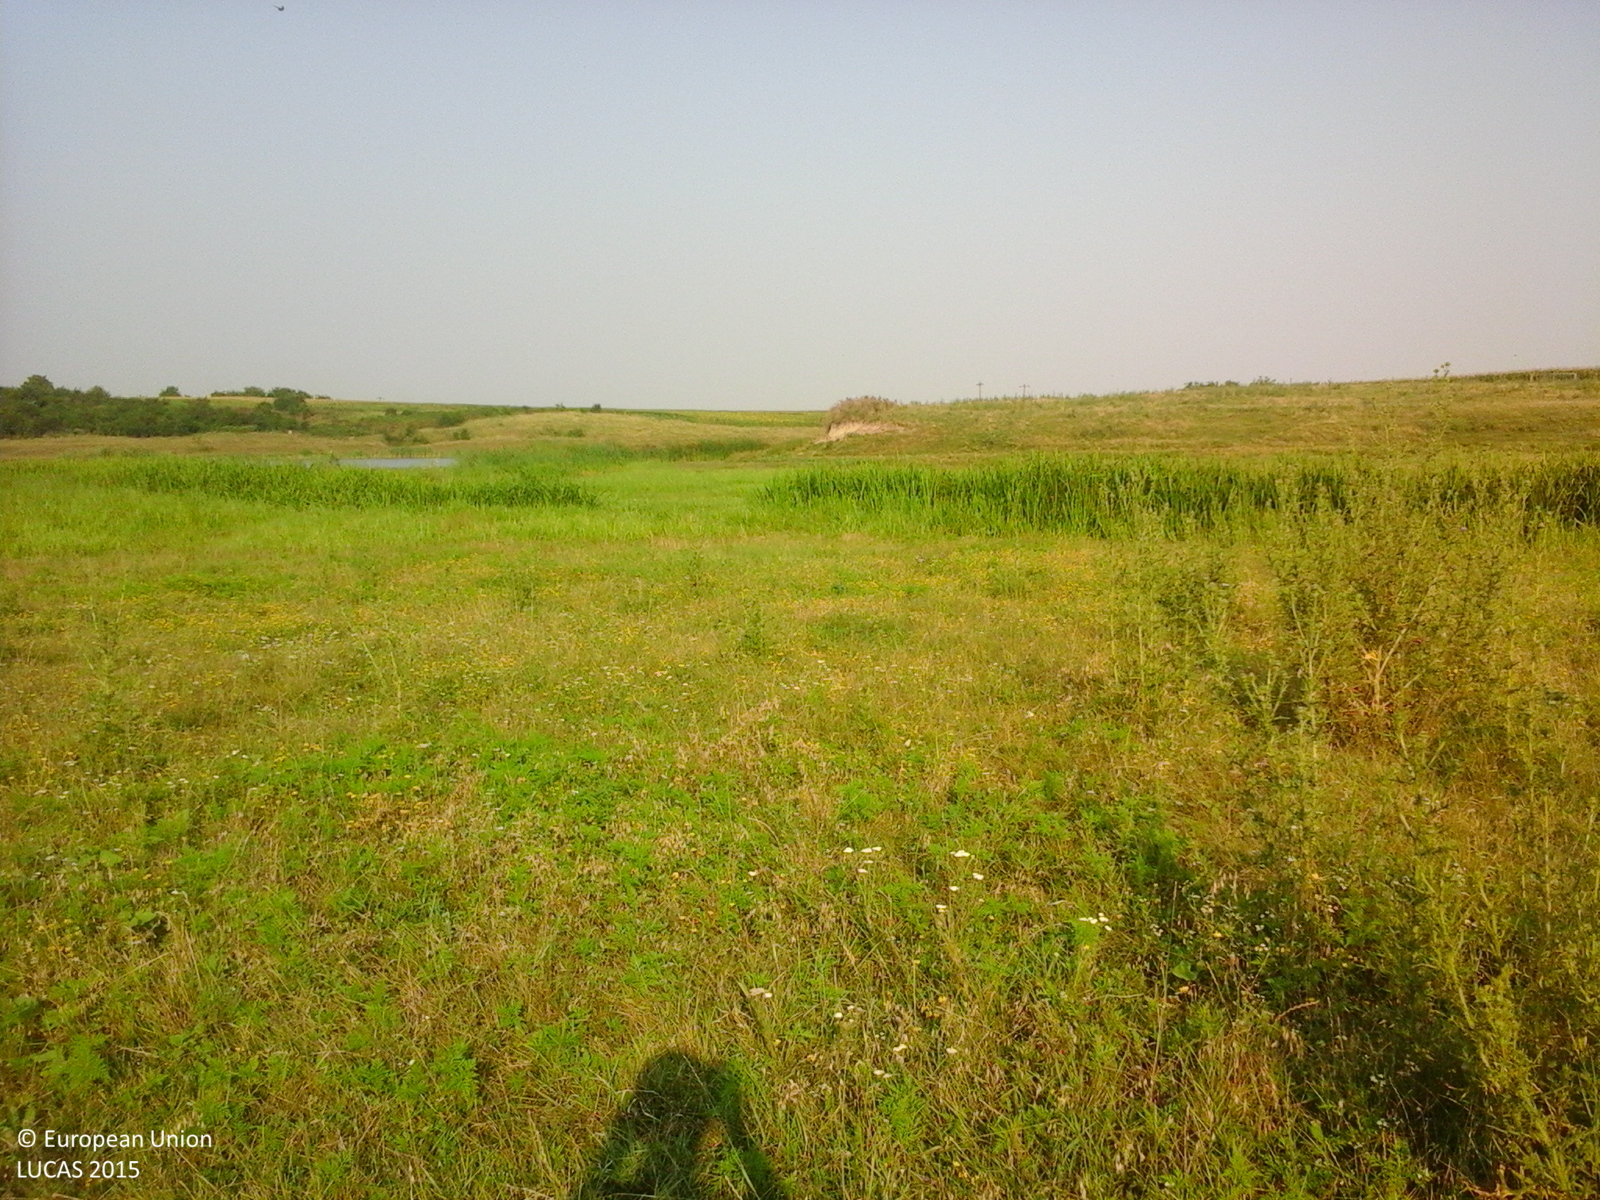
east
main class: Grassland
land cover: Spontaneously vegetated surfaces
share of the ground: > 75 %
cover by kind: herbaceous plants 100 %
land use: Fallow land
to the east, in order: Spontaneously vegetated surfaces; Inland marshes; Rivers and streams; Inland marshes; Inland fresh running water
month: July
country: RO
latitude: 44.4594
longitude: 26.5689
